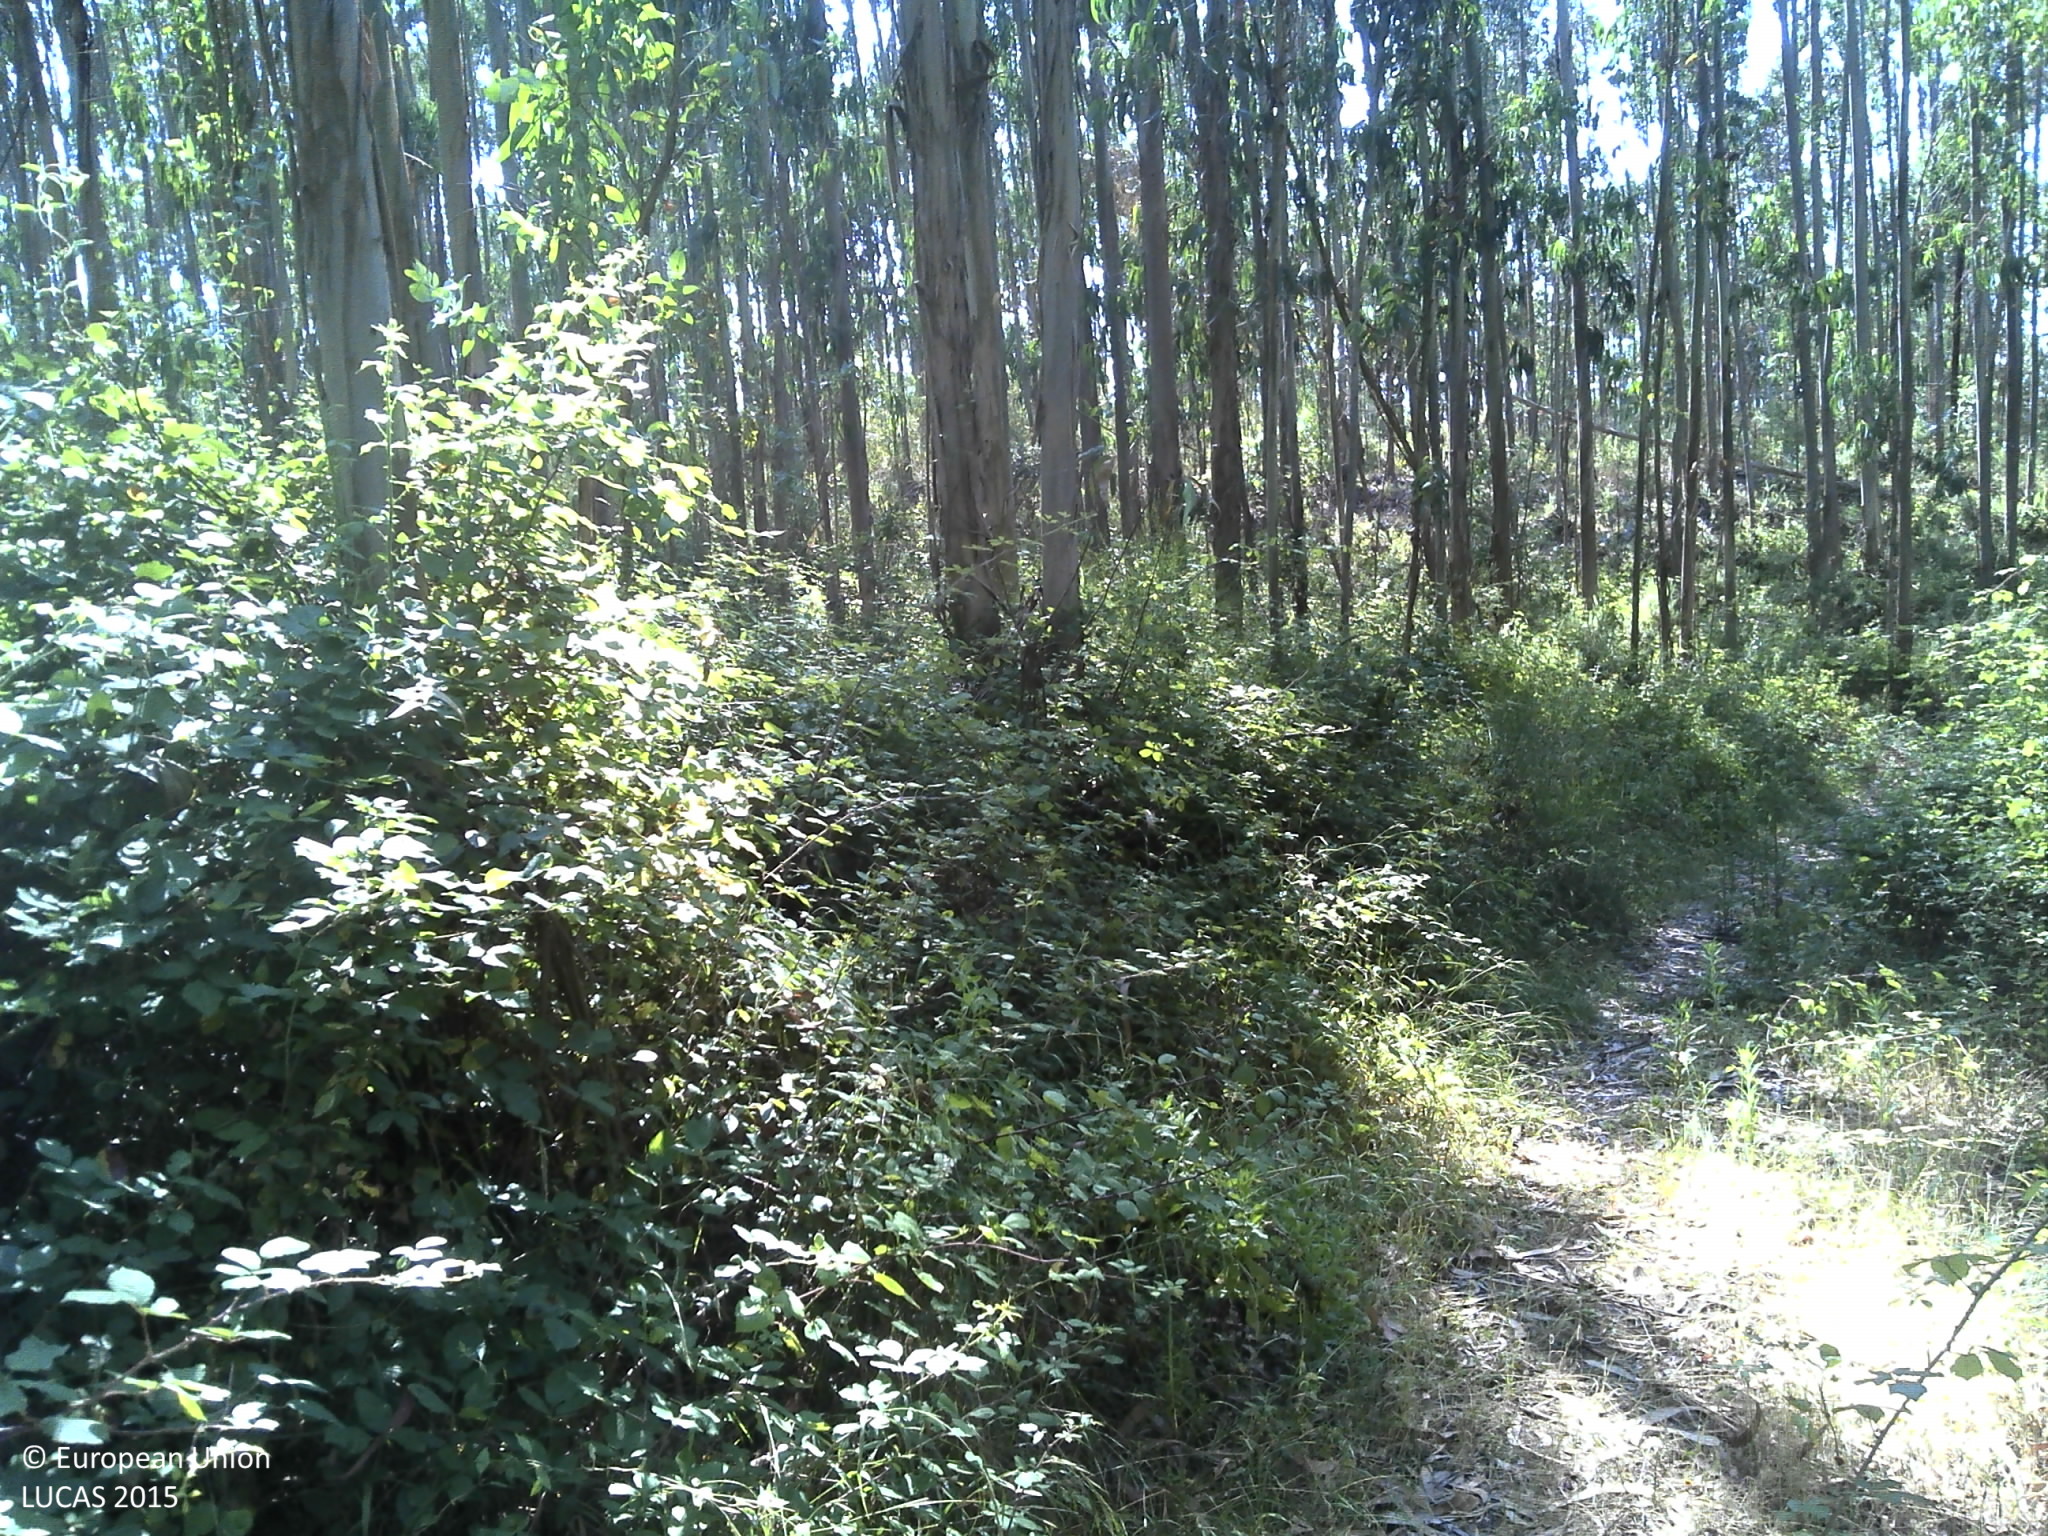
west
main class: Woodland
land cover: Broadleaved woodland
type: exotic forest
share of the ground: > 75 %
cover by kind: broadleaved forest trees 80 %, shrubs 10 %, unconsolidated bare surface 10 %
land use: Forestry
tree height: > 5 m
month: June
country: PT
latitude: 39.2107
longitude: -9.2553
